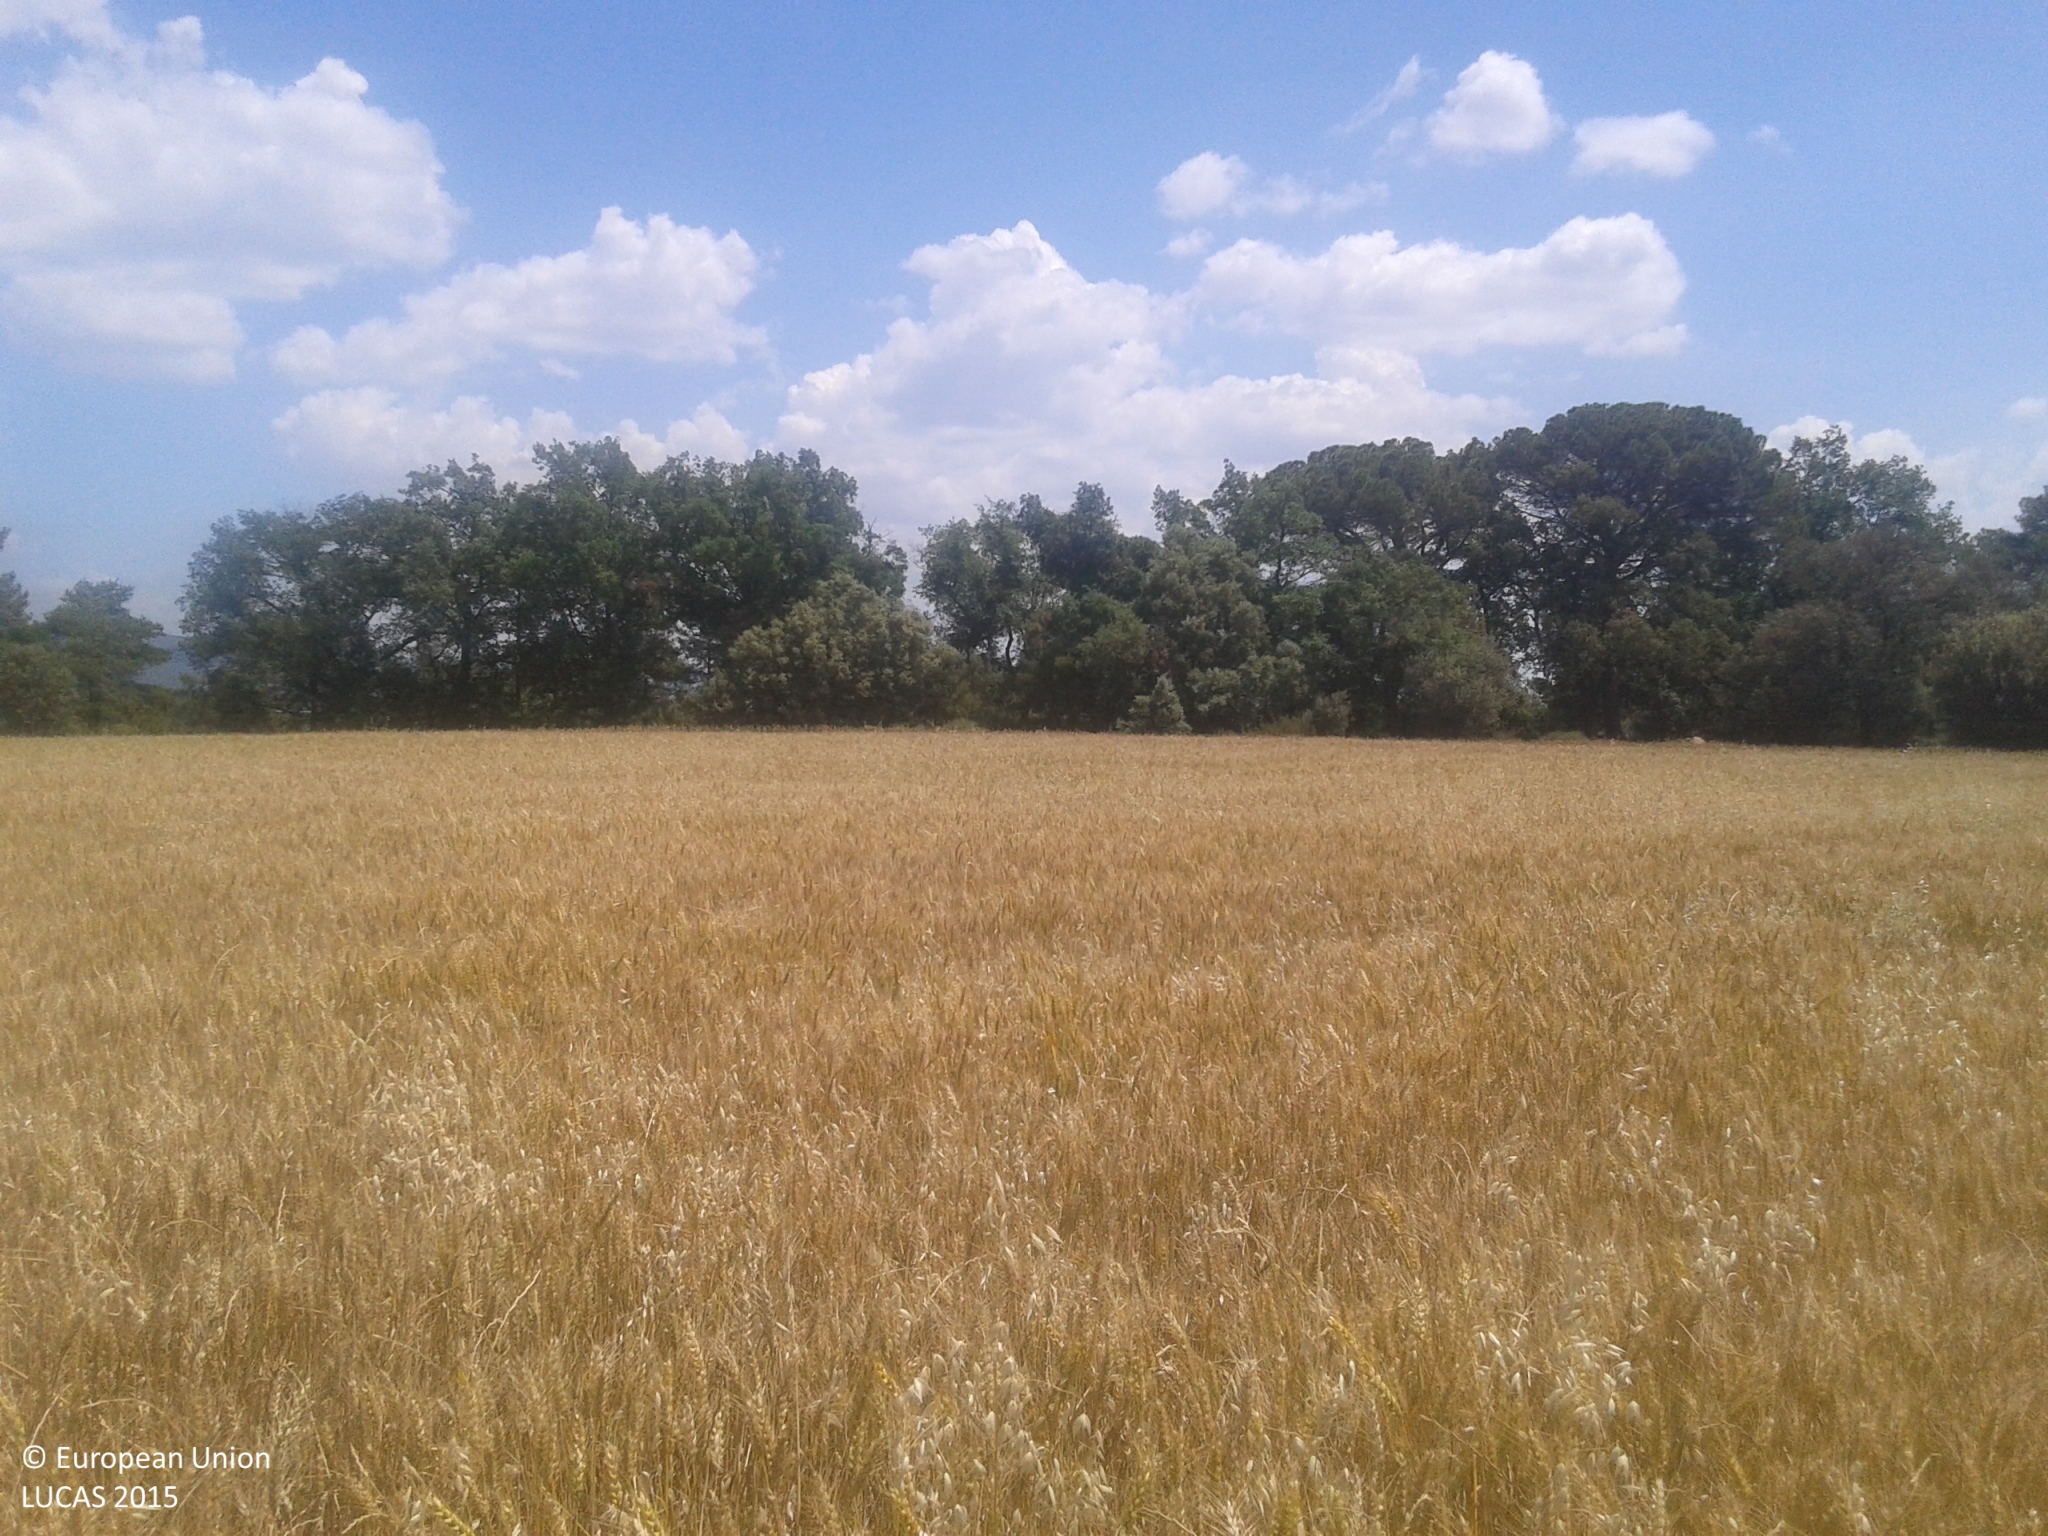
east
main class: Cropland
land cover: Common wheat
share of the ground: > 75 %
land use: Agriculture (excluding fallow land and kitchen gardens)
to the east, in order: Common wheat; Other mixed woodland; Tracks; Pine dominated mixed woodland; Common wheat; Pine dominated mixed woodland
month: June
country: ES
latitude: 41.9939
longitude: 1.5747
